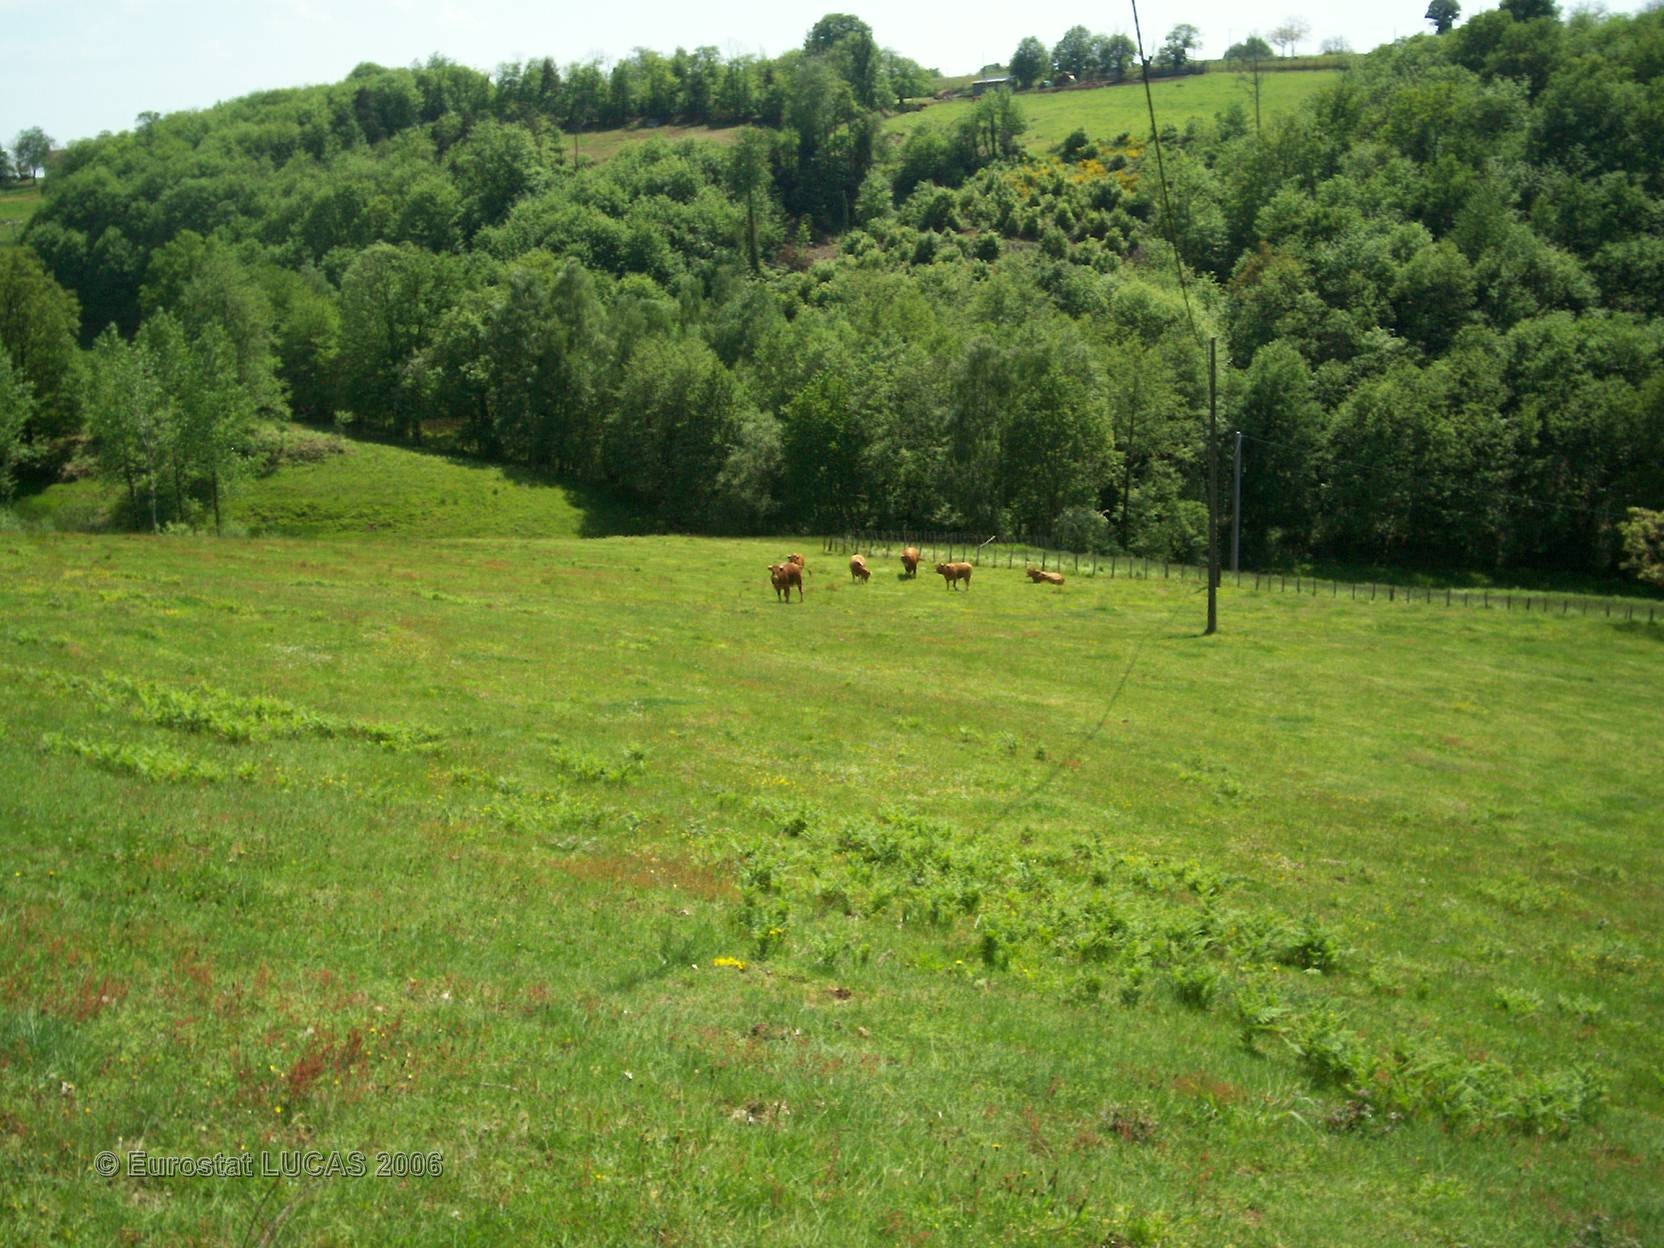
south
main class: Grassland
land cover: Grassland without tree/shrub cover
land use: Agriculture (excluding fallow land and kitchen gardens)
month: May
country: FR
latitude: 45.1085
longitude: 1.7479
